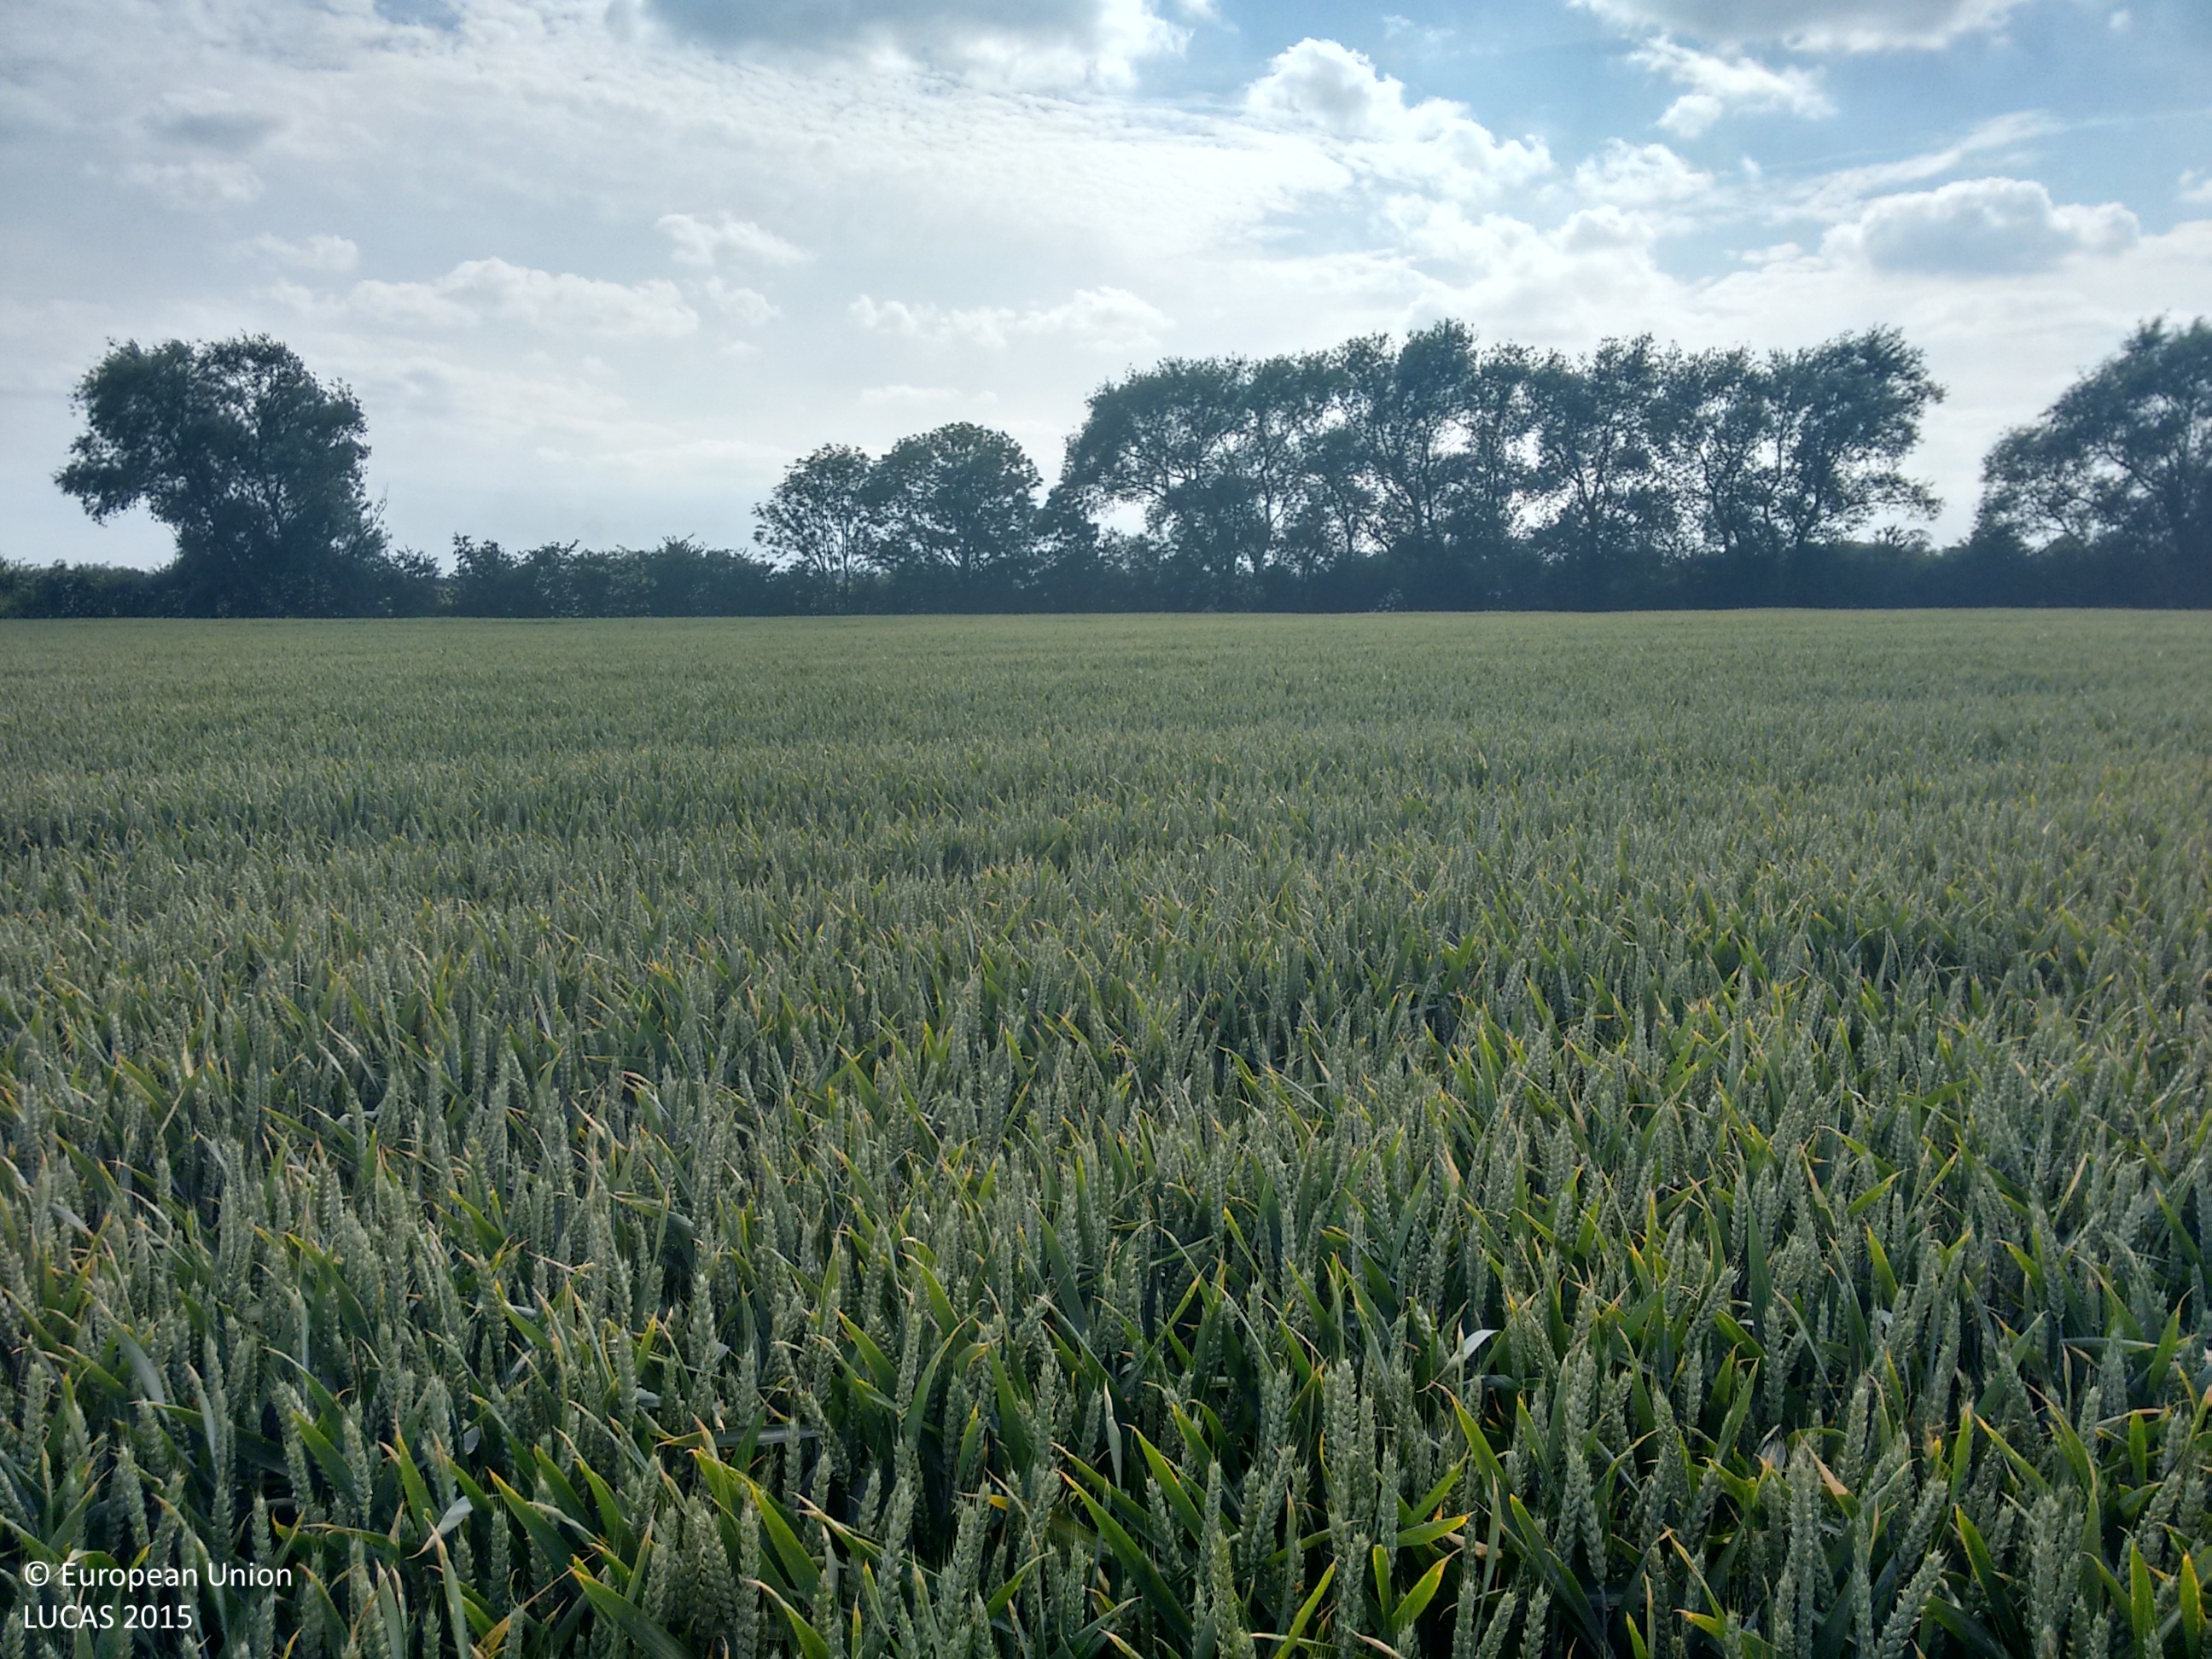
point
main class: Cropland
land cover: Common wheat
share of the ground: > 75 %
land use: Agriculture (excluding fallow land and kitchen gardens)
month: June
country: GB
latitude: 53.7351
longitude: -1.1877
